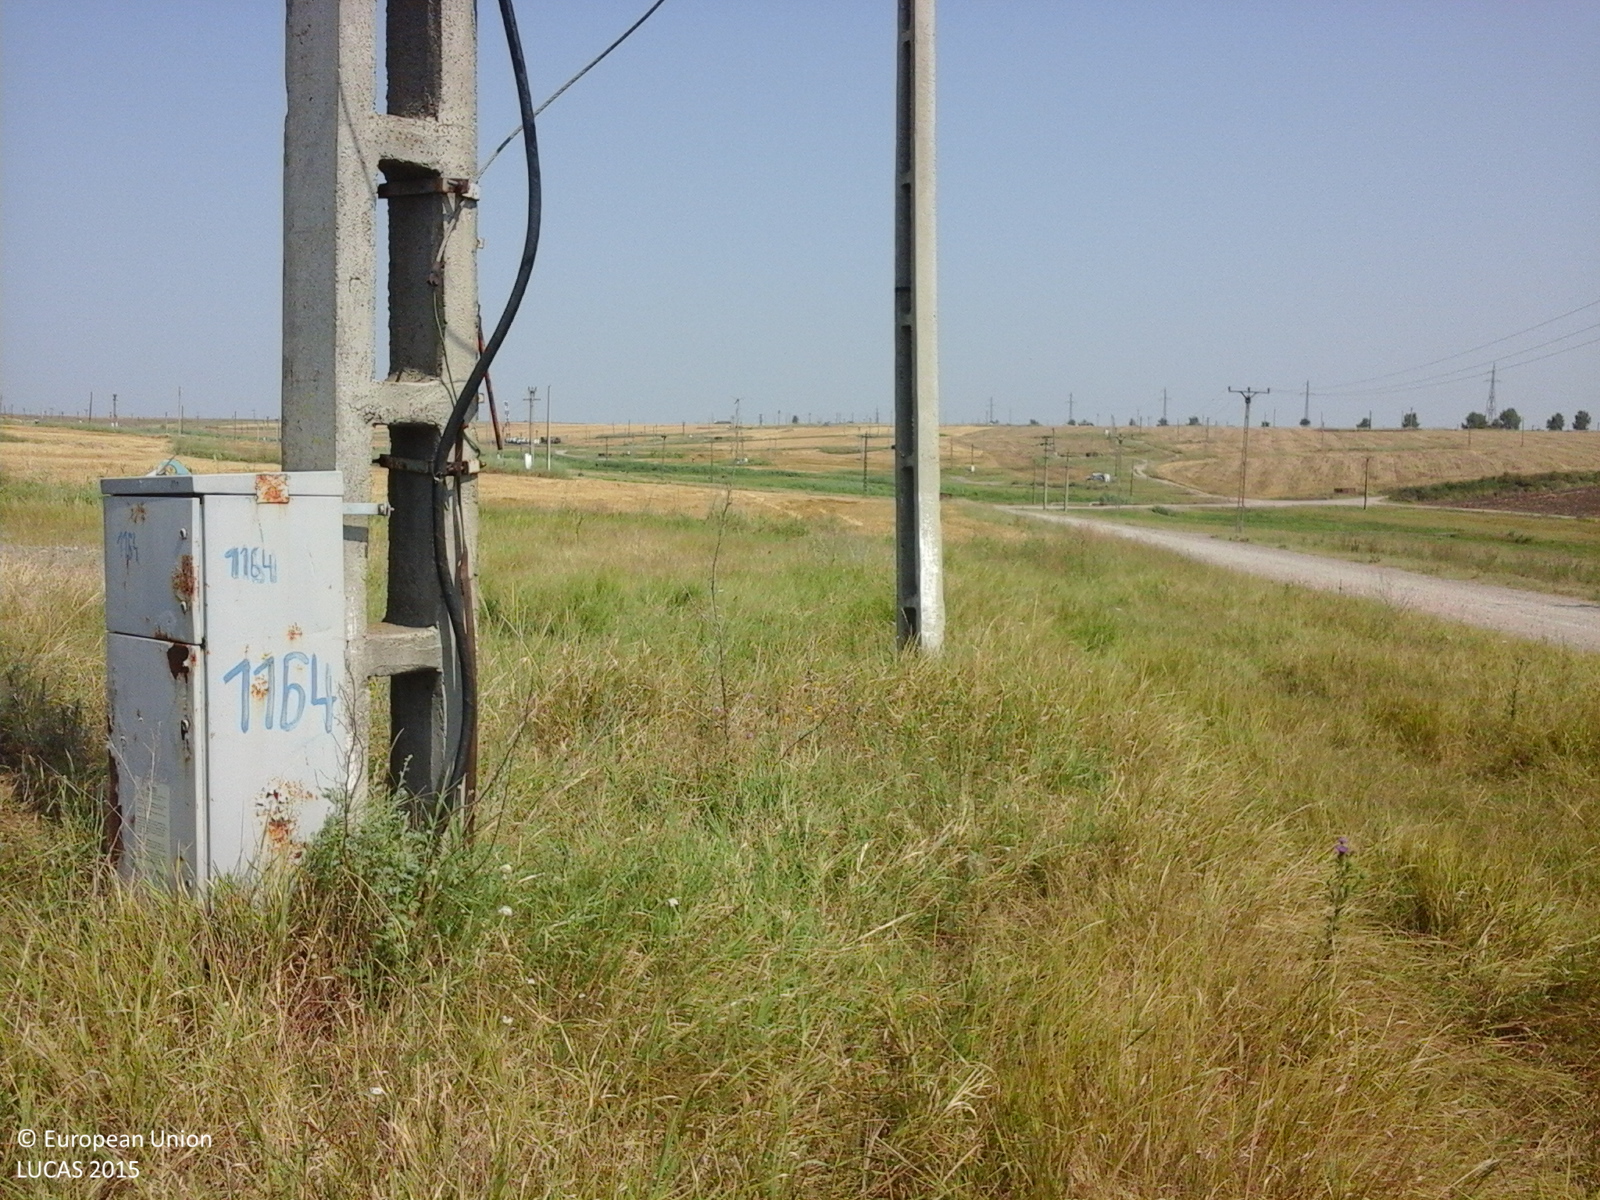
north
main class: Grassland
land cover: Grassland without tree/shrub cover
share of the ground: > 75 %
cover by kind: herbaceous plants 100 %
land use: Agriculture (excluding fallow land and kitchen gardens)
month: July
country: RO
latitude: 45.5213
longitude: 27.8180
